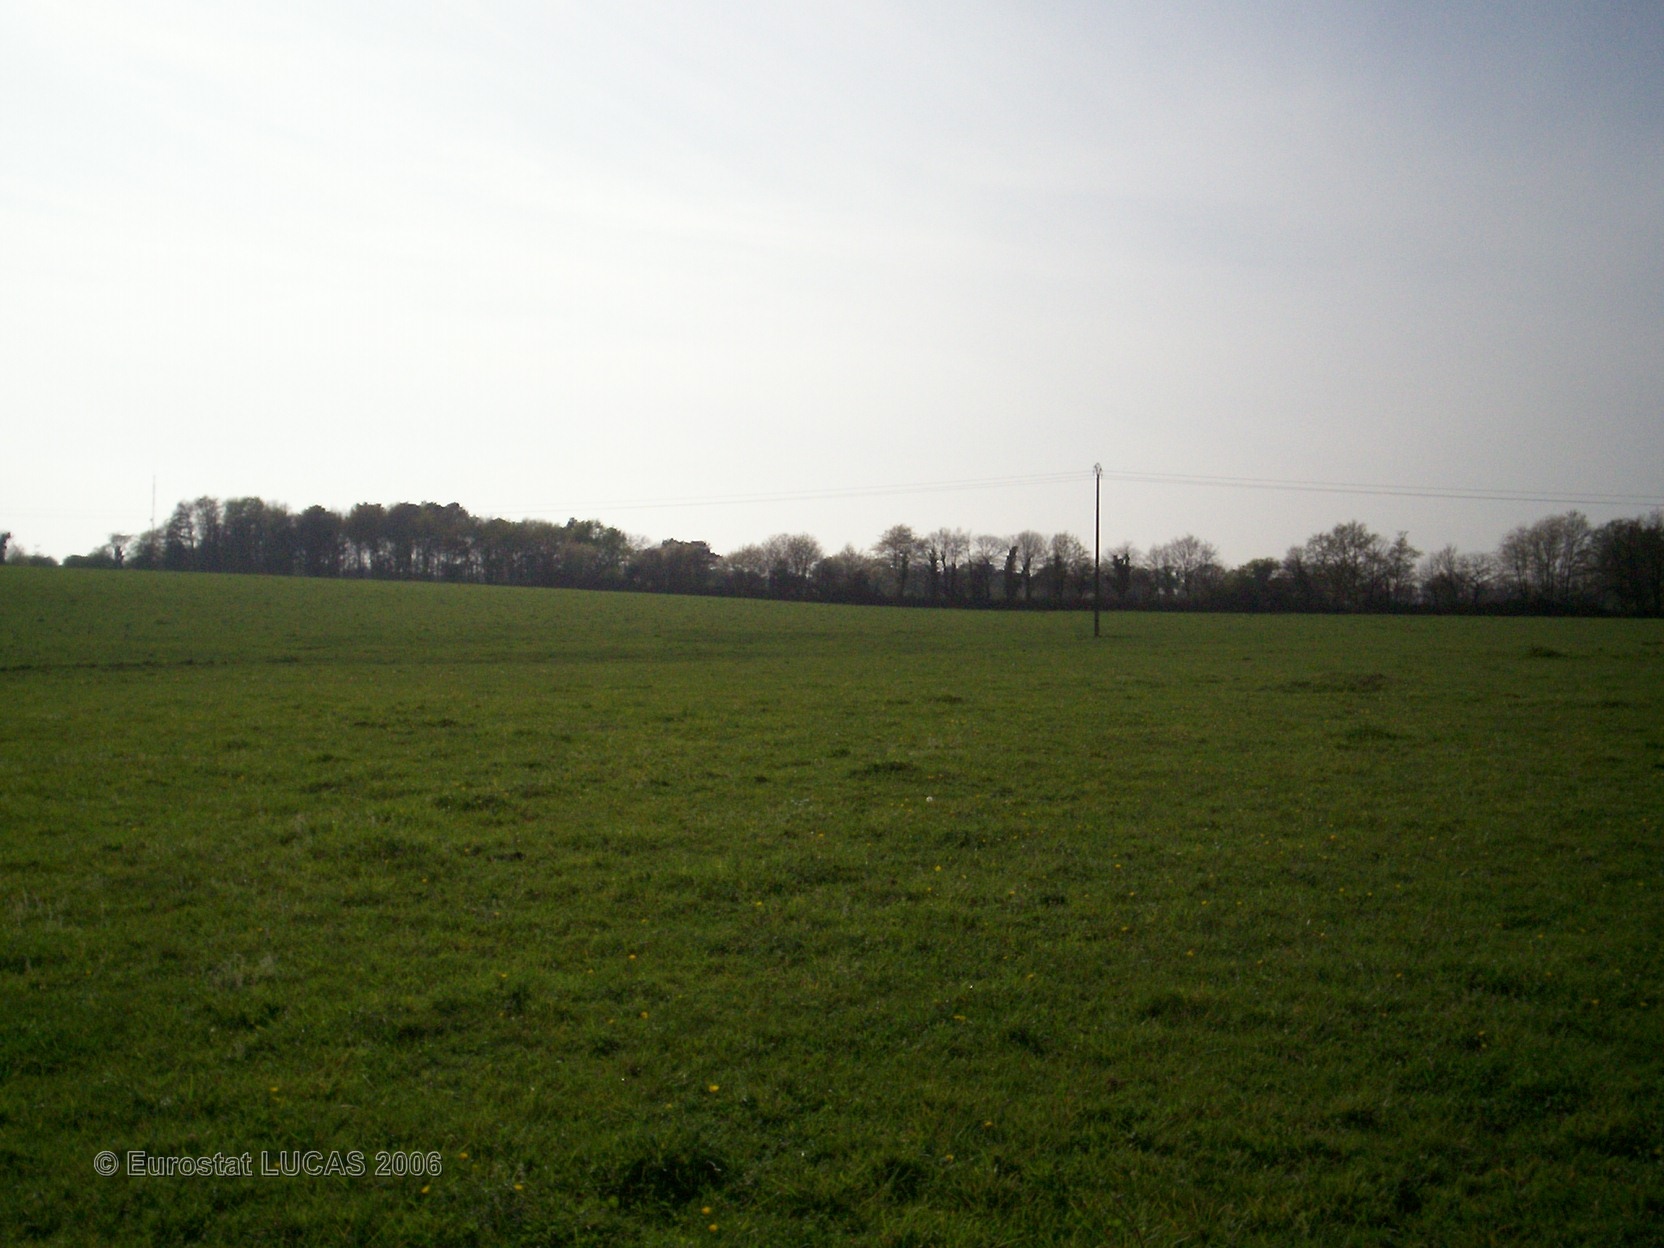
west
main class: Grassland
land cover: Grassland without tree/shrub cover
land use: Agriculture (excluding fallow land and kitchen gardens)
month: April
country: FR
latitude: 47.6522
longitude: -2.8308
